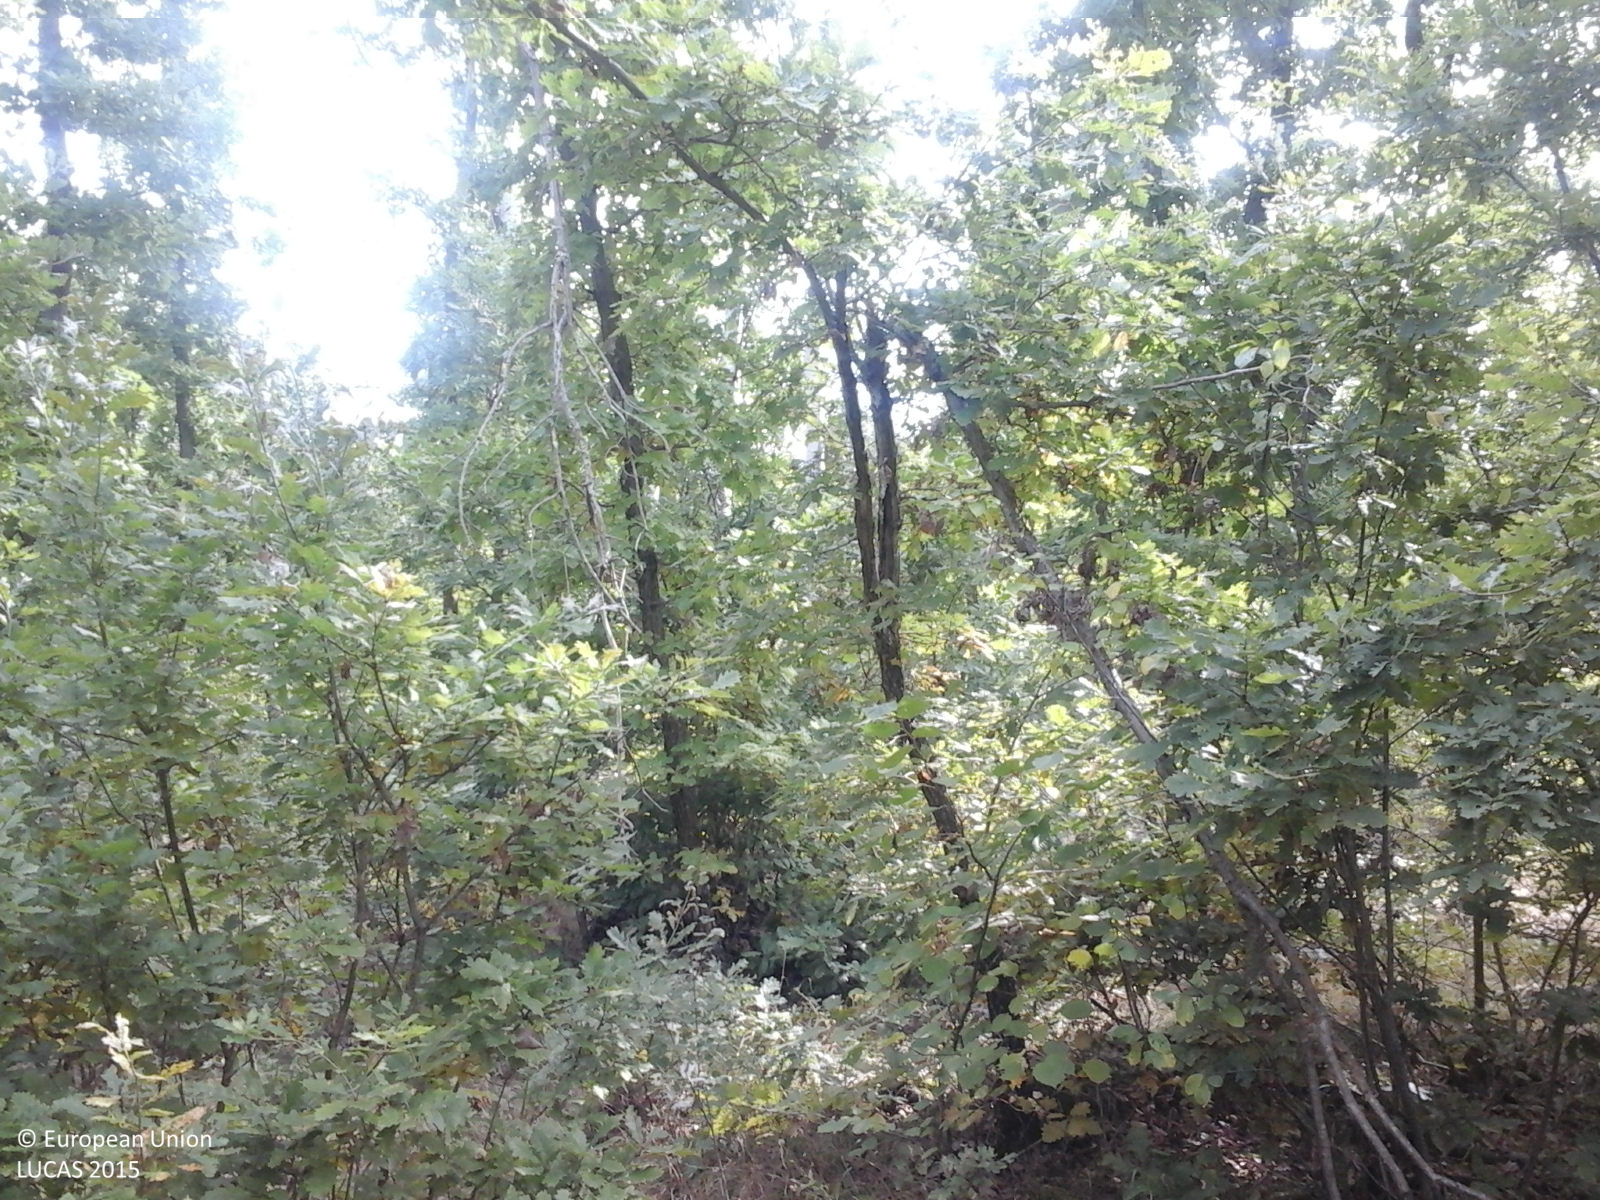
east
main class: Woodland
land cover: Broadleaved woodland
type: acidophilous oak and oak-birch forest
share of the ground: > 75 %
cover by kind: broadleaved forest trees 100 %
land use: Forestry
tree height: > 5 m
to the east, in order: Broadleaved woodland; Tracks; Broadleaved woodland
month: September
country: RO
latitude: 46.6566
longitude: 23.5157
